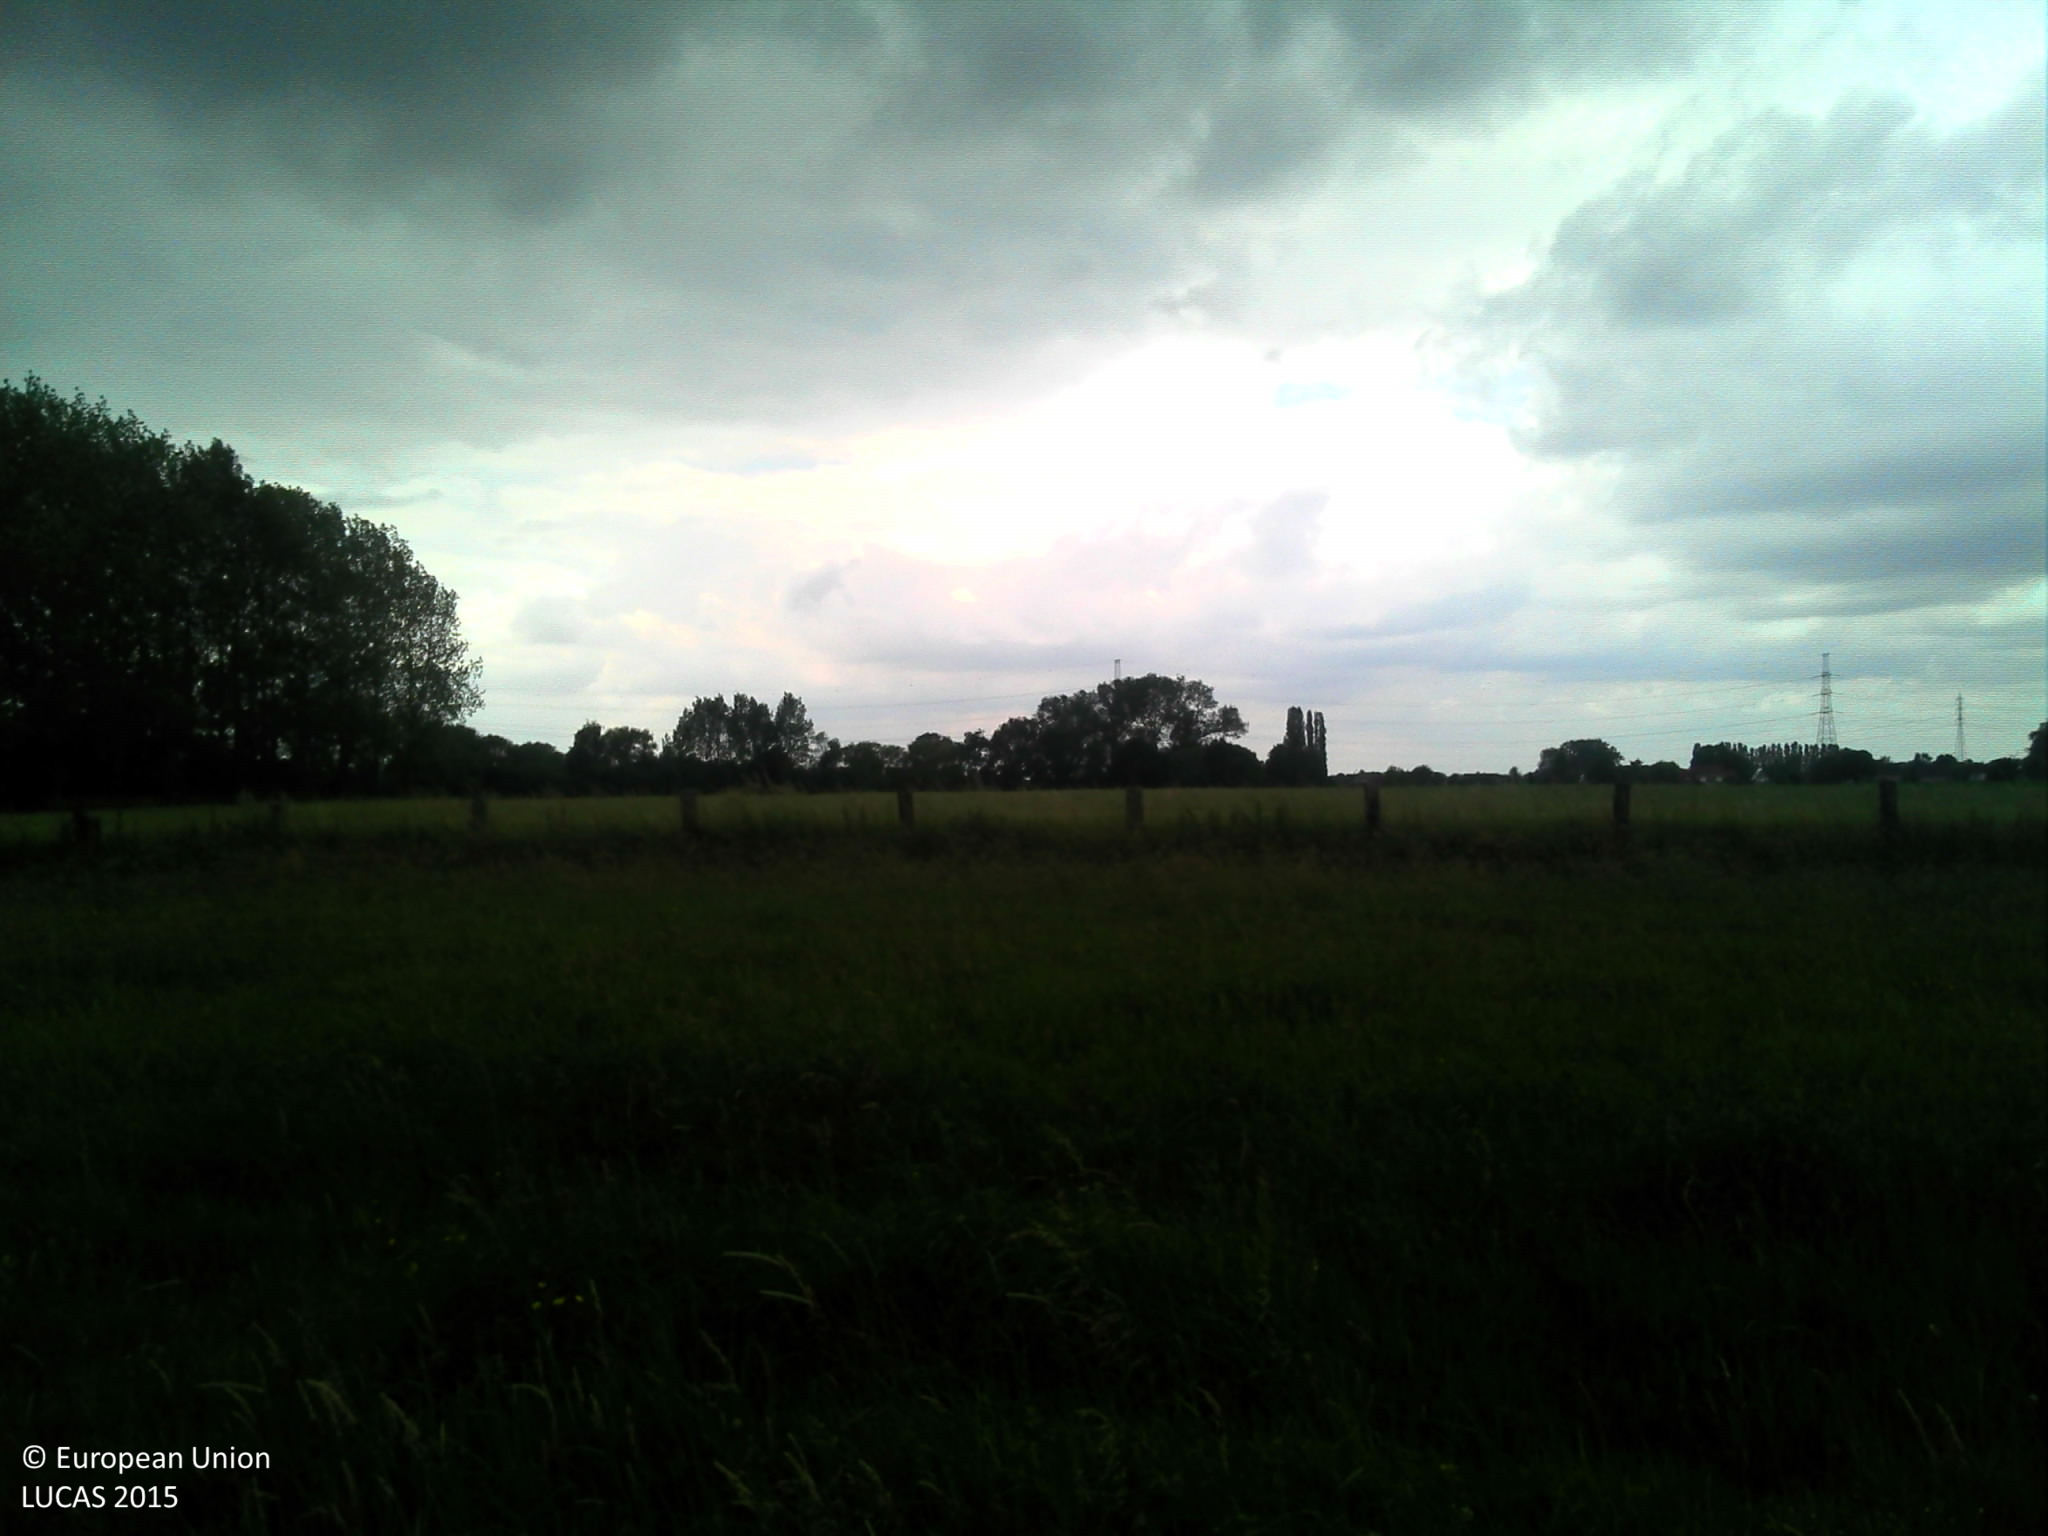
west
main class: Grassland
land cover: Grassland without tree/shrub cover
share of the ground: > 75 %
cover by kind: herbaceous plants 100 %
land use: Agriculture (excluding fallow land and kitchen gardens)
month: June
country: BE
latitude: 50.9851
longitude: 4.4257
